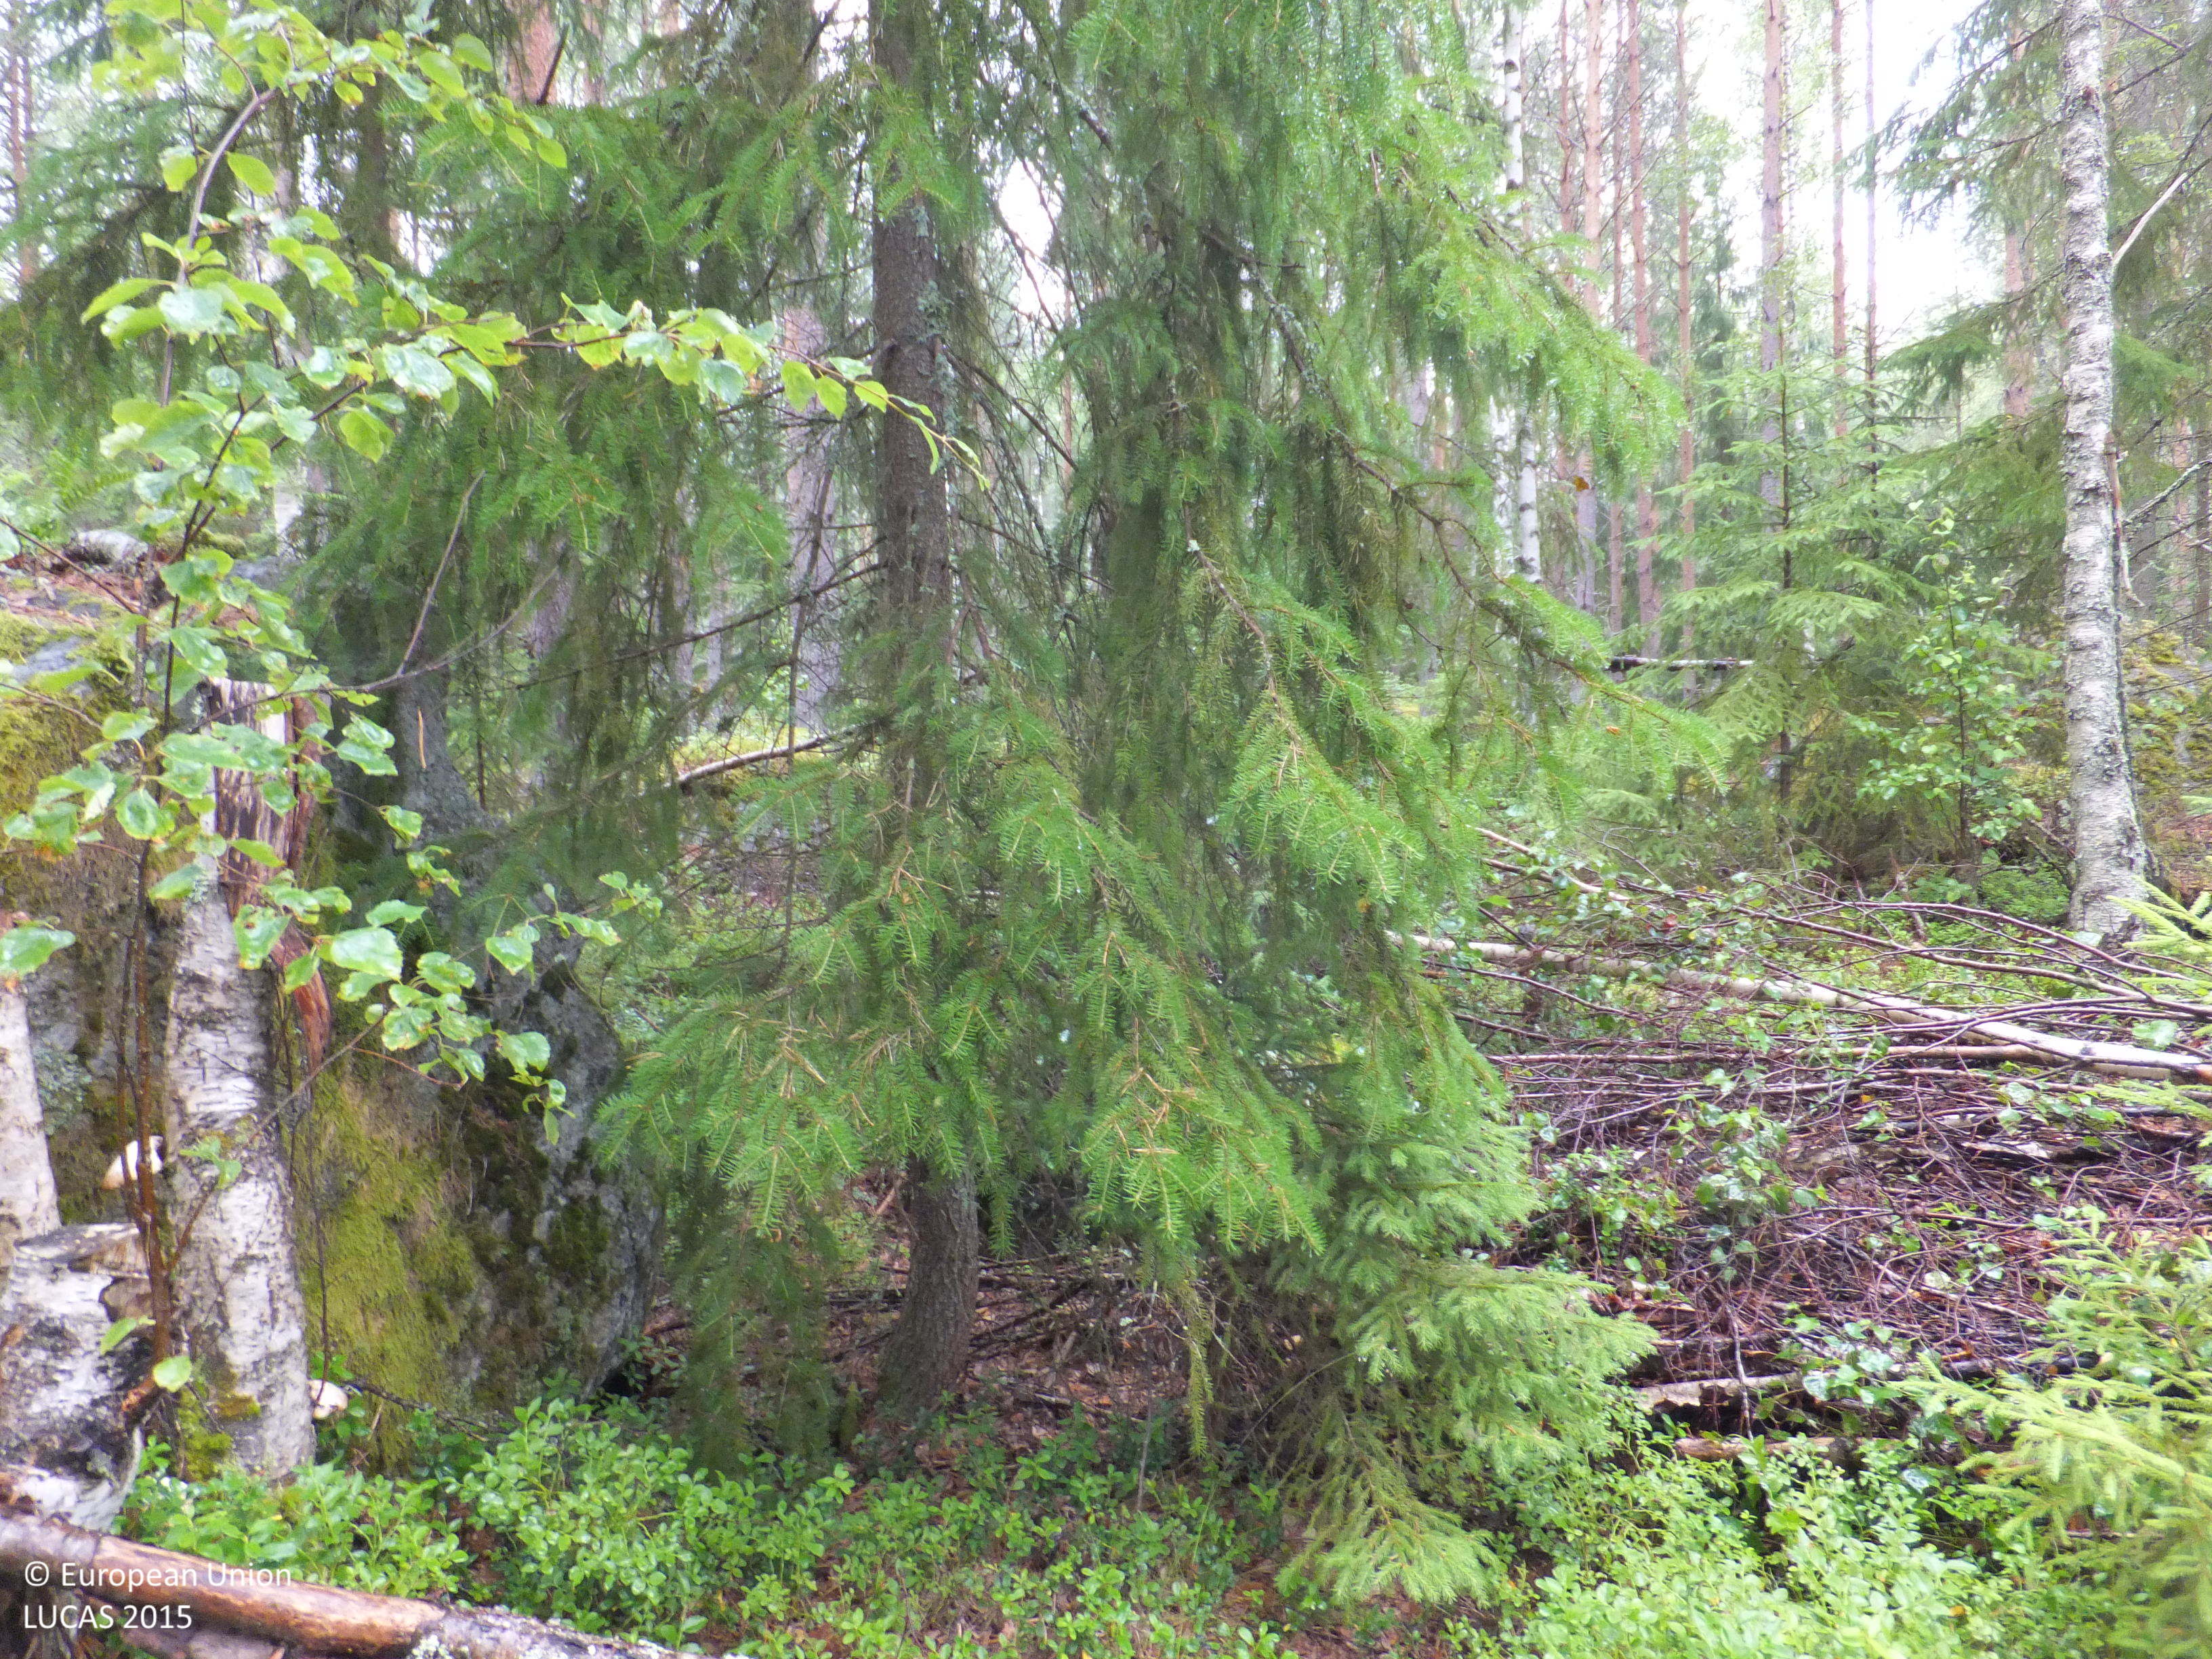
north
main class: Woodland
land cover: Other mixed woodland
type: boreal forest
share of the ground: > 75 %
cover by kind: coniferous forest trees 55 %, broadleaved forest trees 20 %, shrubs 10 %, herbaceous plants 5 %, lichens and mosses 5 %, consolidated bare surface 5 %
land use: Forestry
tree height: > 5 m
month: July
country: FI
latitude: 63.2304
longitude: 21.9633
